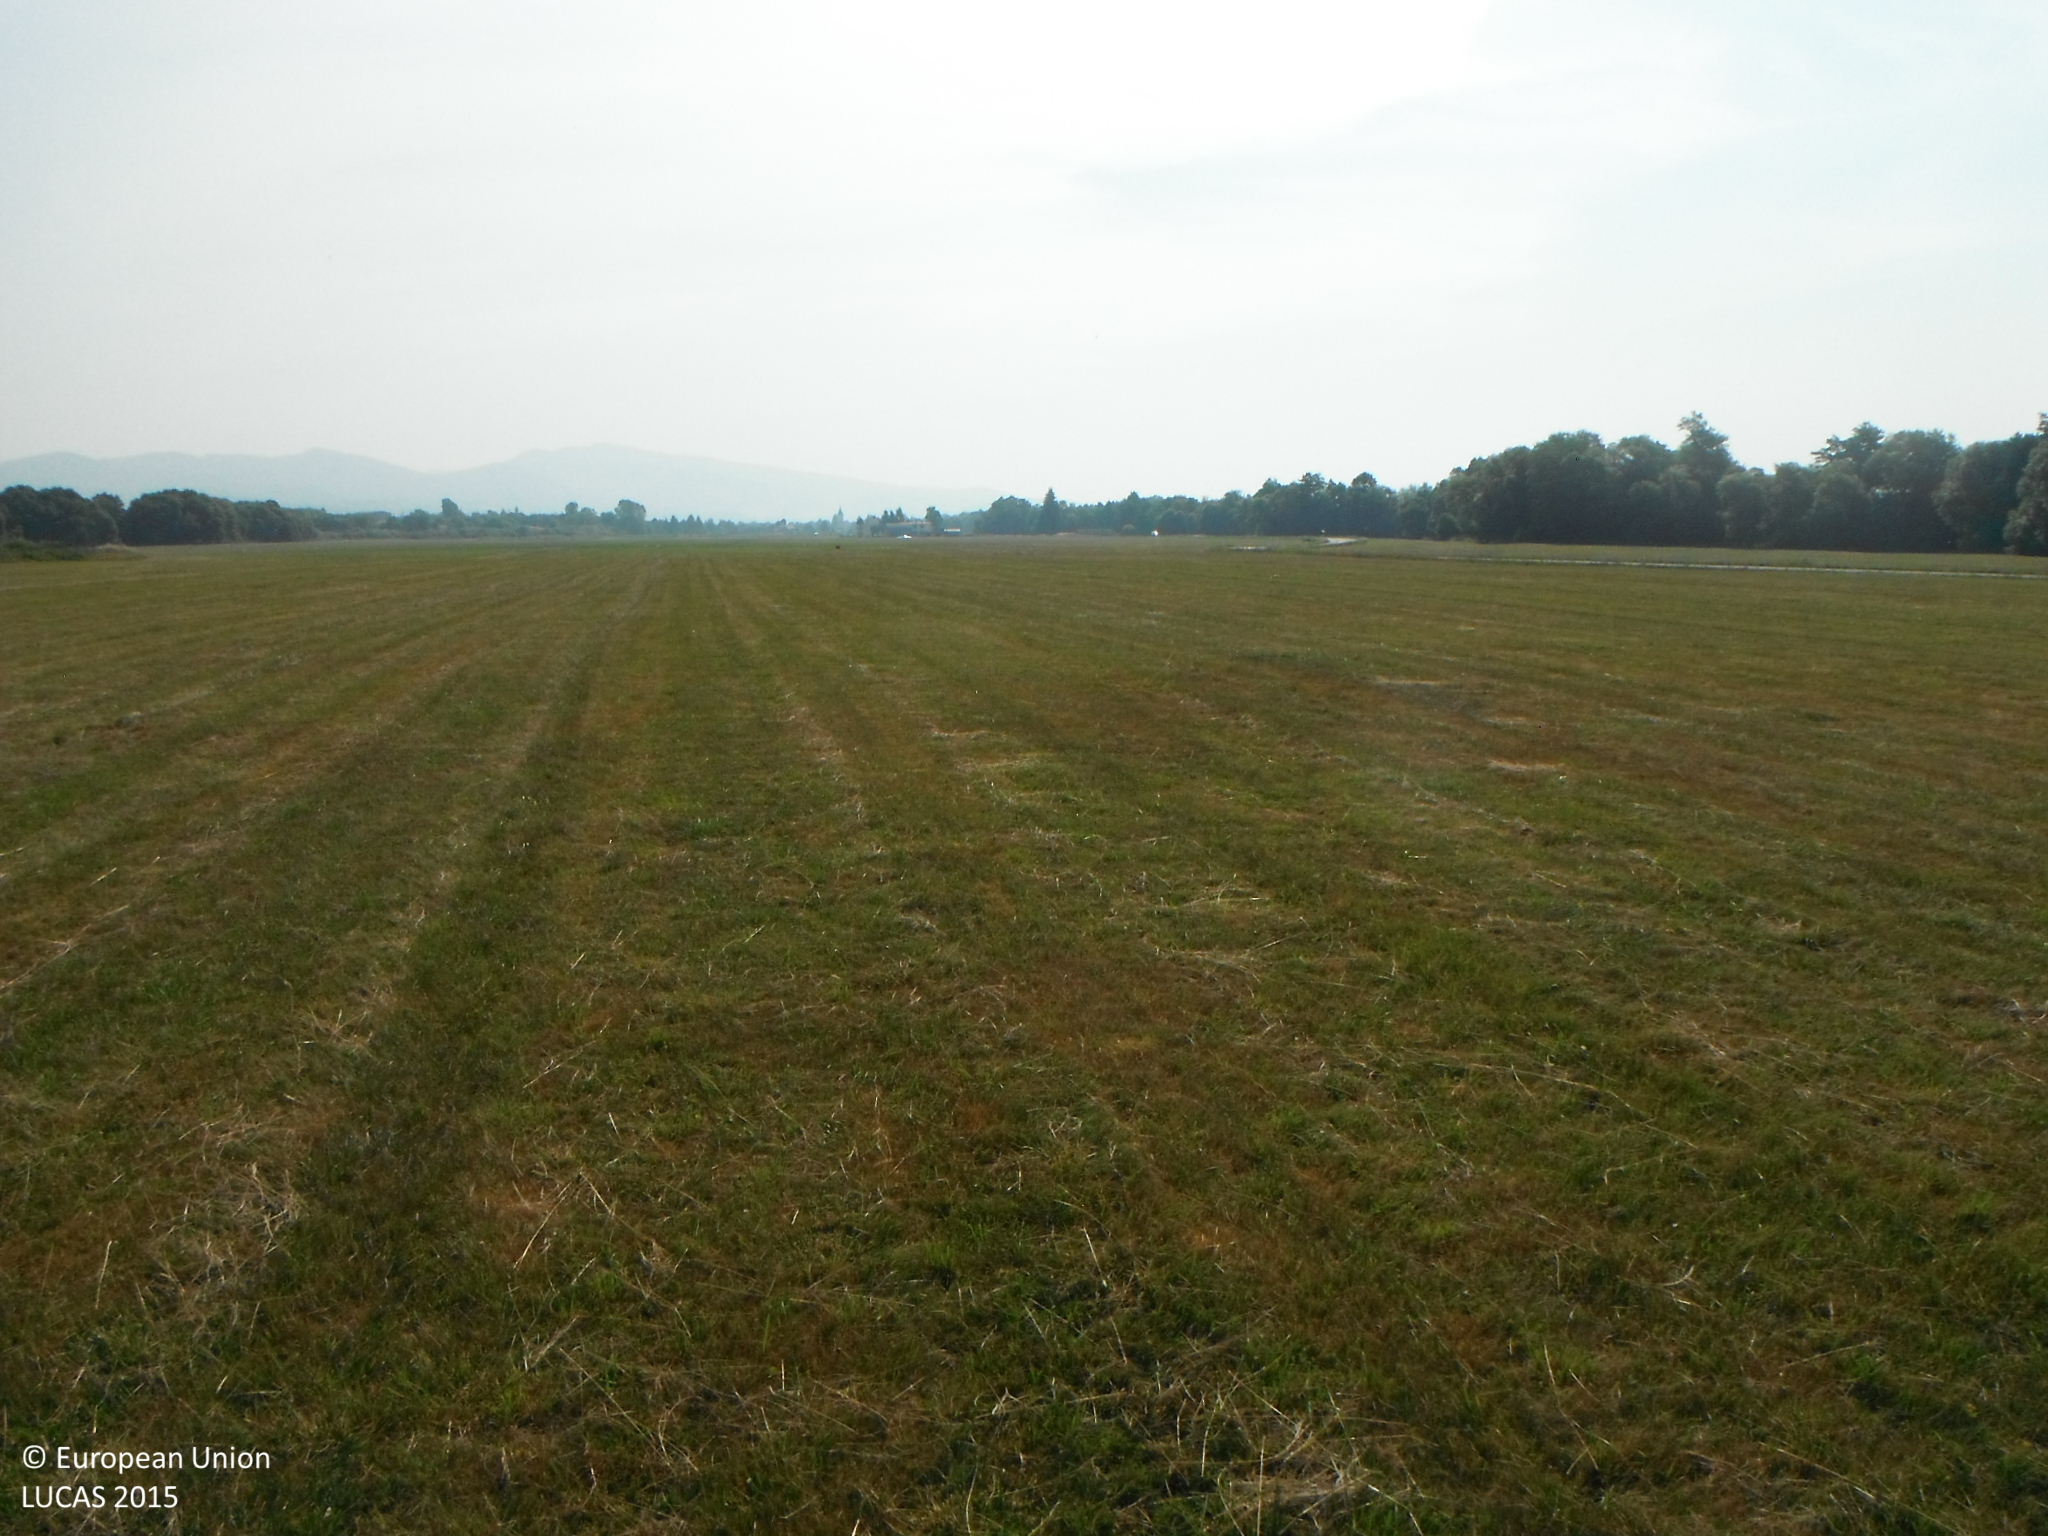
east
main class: Grassland
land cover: Grassland without tree/shrub cover
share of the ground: > 75 %
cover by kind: herbaceous plants 100 %
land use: Agriculture (excluding fallow land and kitchen gardens)
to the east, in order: Grassland without tree/shrub cover
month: July
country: SK
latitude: 48.5940
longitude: 19.2565
